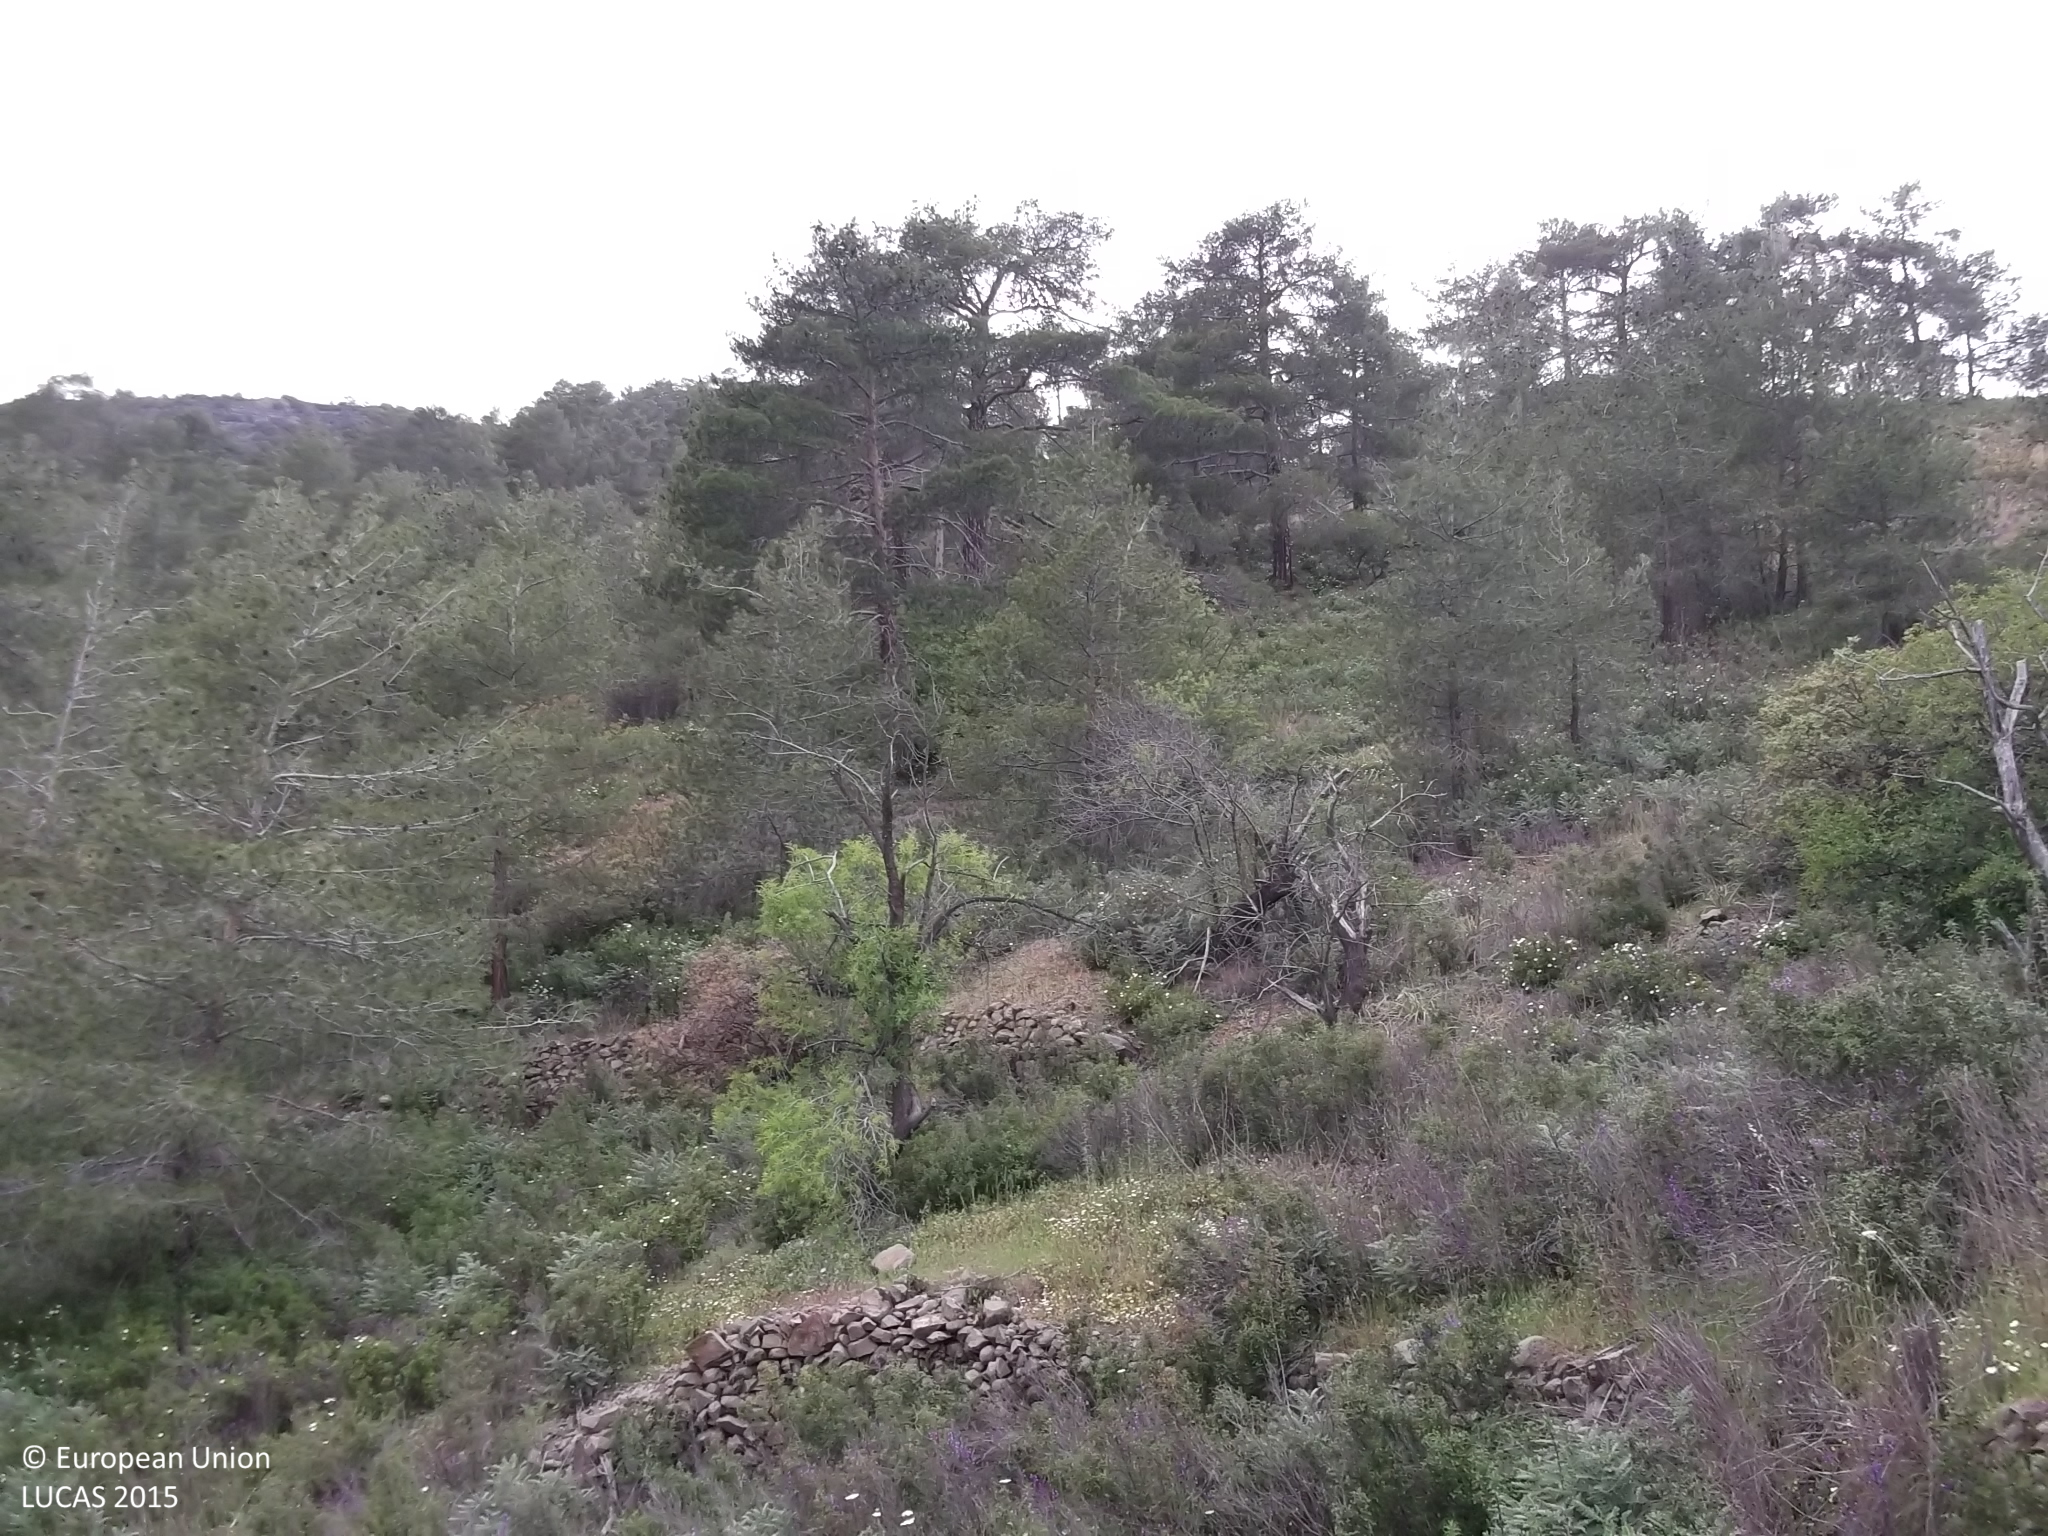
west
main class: Woodland
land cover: Pine dominated coniferous woodland
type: coniferous forest of the mediterranean region
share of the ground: 10 - 25 %
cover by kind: shrubs 30 %, coniferous forest trees 25 %, unconsolidated bare surface 25 %, consolidated bare surface 20 %
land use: Semi-natural and natural areas not in use
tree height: > 5 m
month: April
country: CY
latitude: 34.9514
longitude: 33.1177
